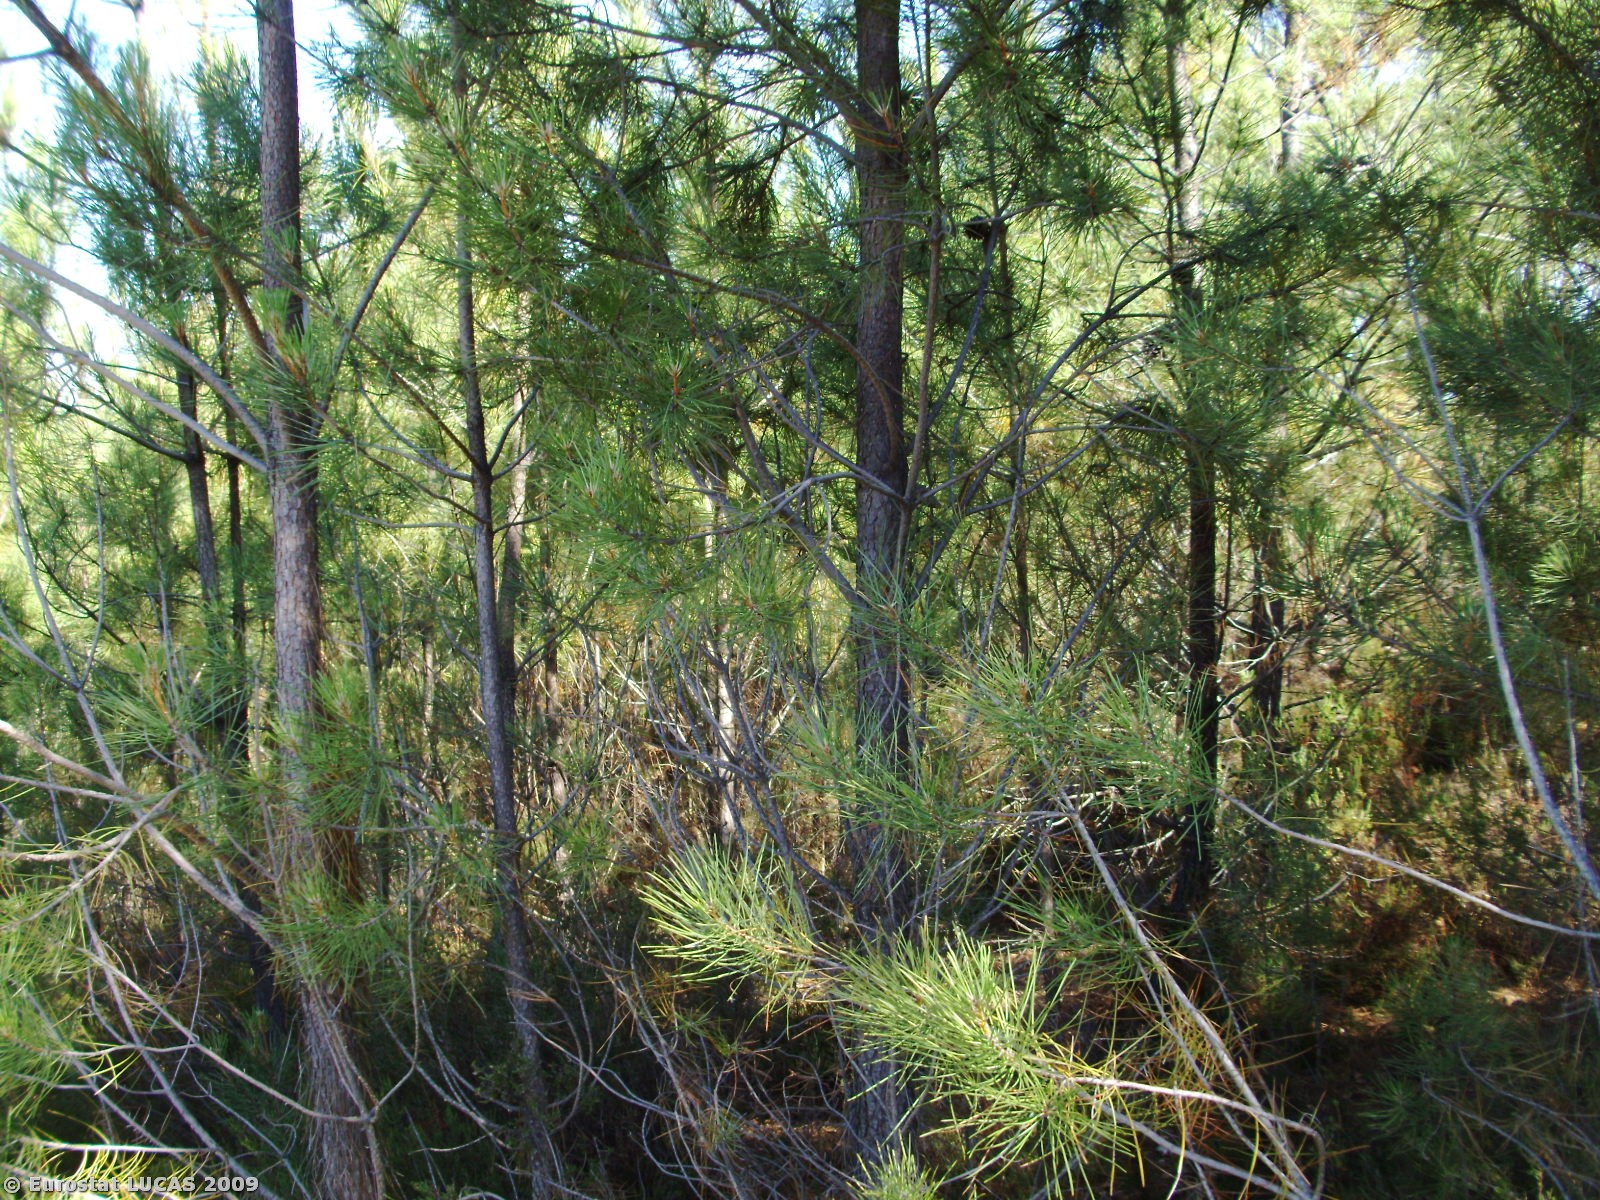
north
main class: Woodland
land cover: Coniferous woodland
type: coniferous forest of the mediterranean region
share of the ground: > 75 %
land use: Forestry
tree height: > 5 m
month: June
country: PT
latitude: 40.1110
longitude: -7.5515
